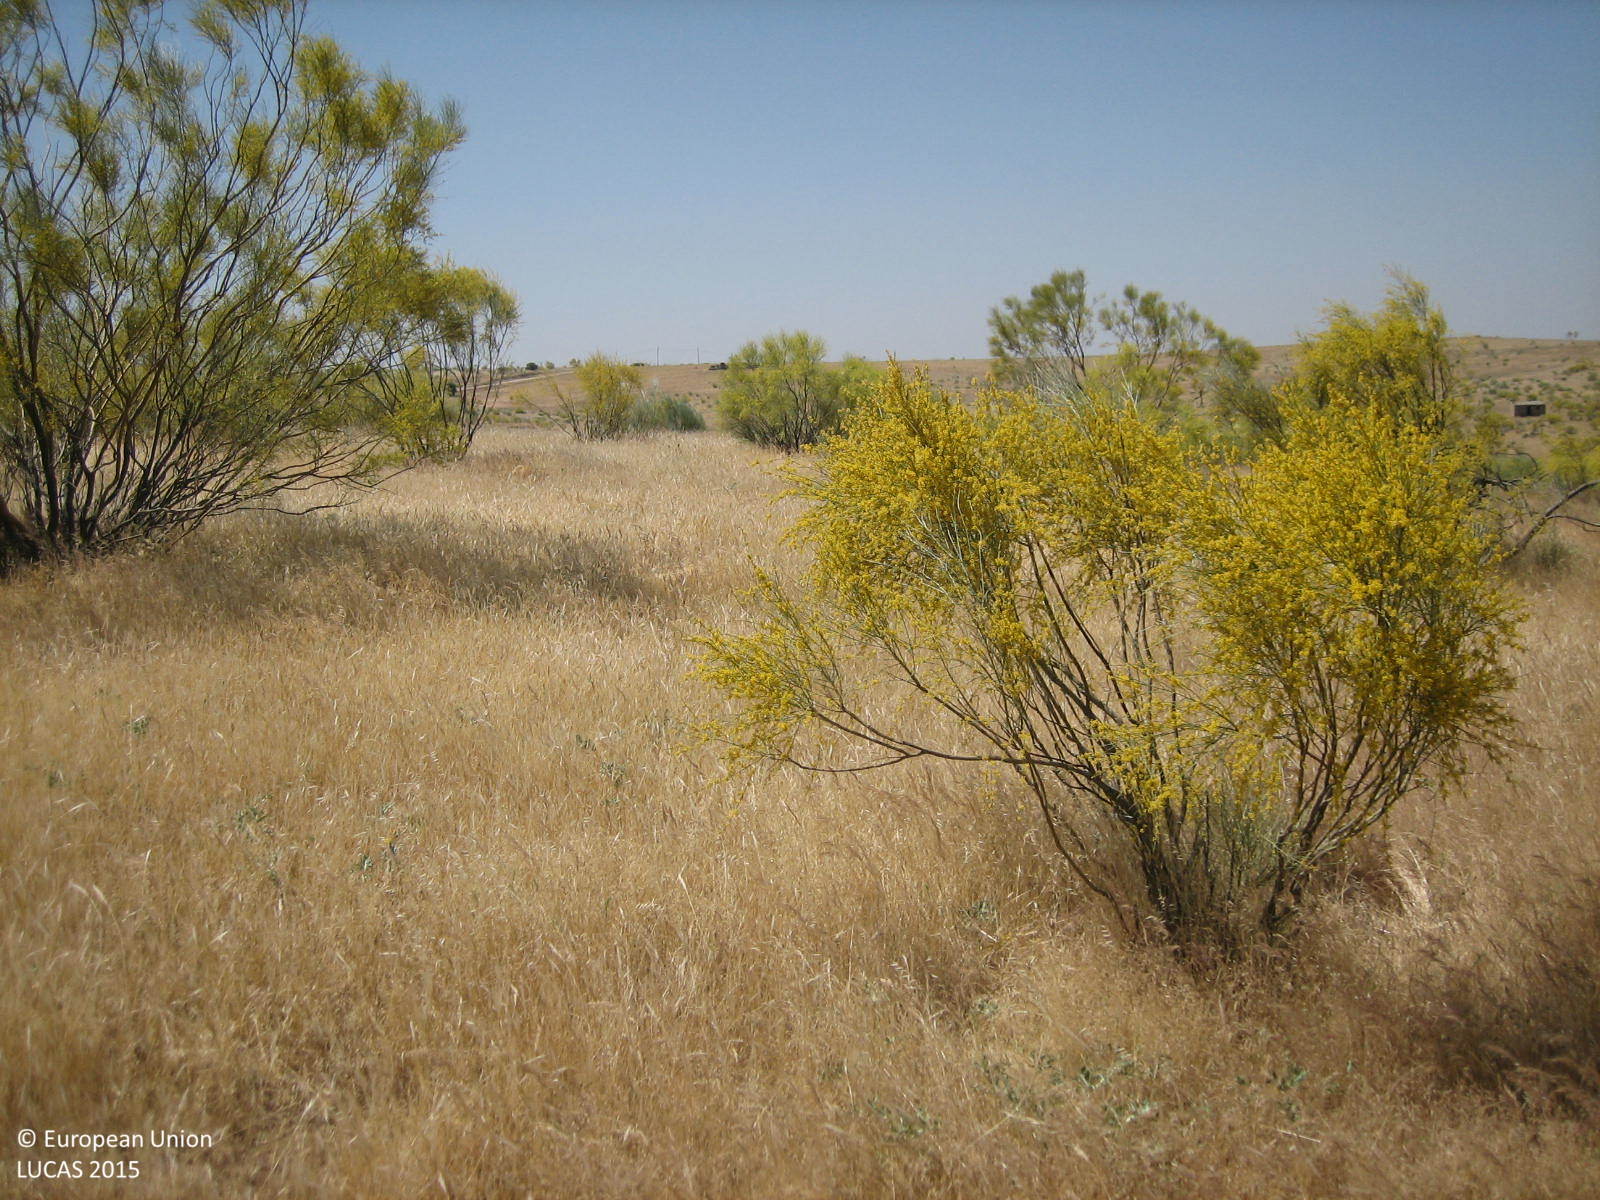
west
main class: Grassland
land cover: Grassland with sparse tree/shrub cover
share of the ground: > 75 %
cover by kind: herbaceous plants 90 %, broadleaved forest trees 5 %, shrubs 5 %
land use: Agriculture (excluding fallow land and kitchen gardens)
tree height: < 5 m
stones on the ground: < 10 %
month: May
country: ES
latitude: 38.9167
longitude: -5.1568
